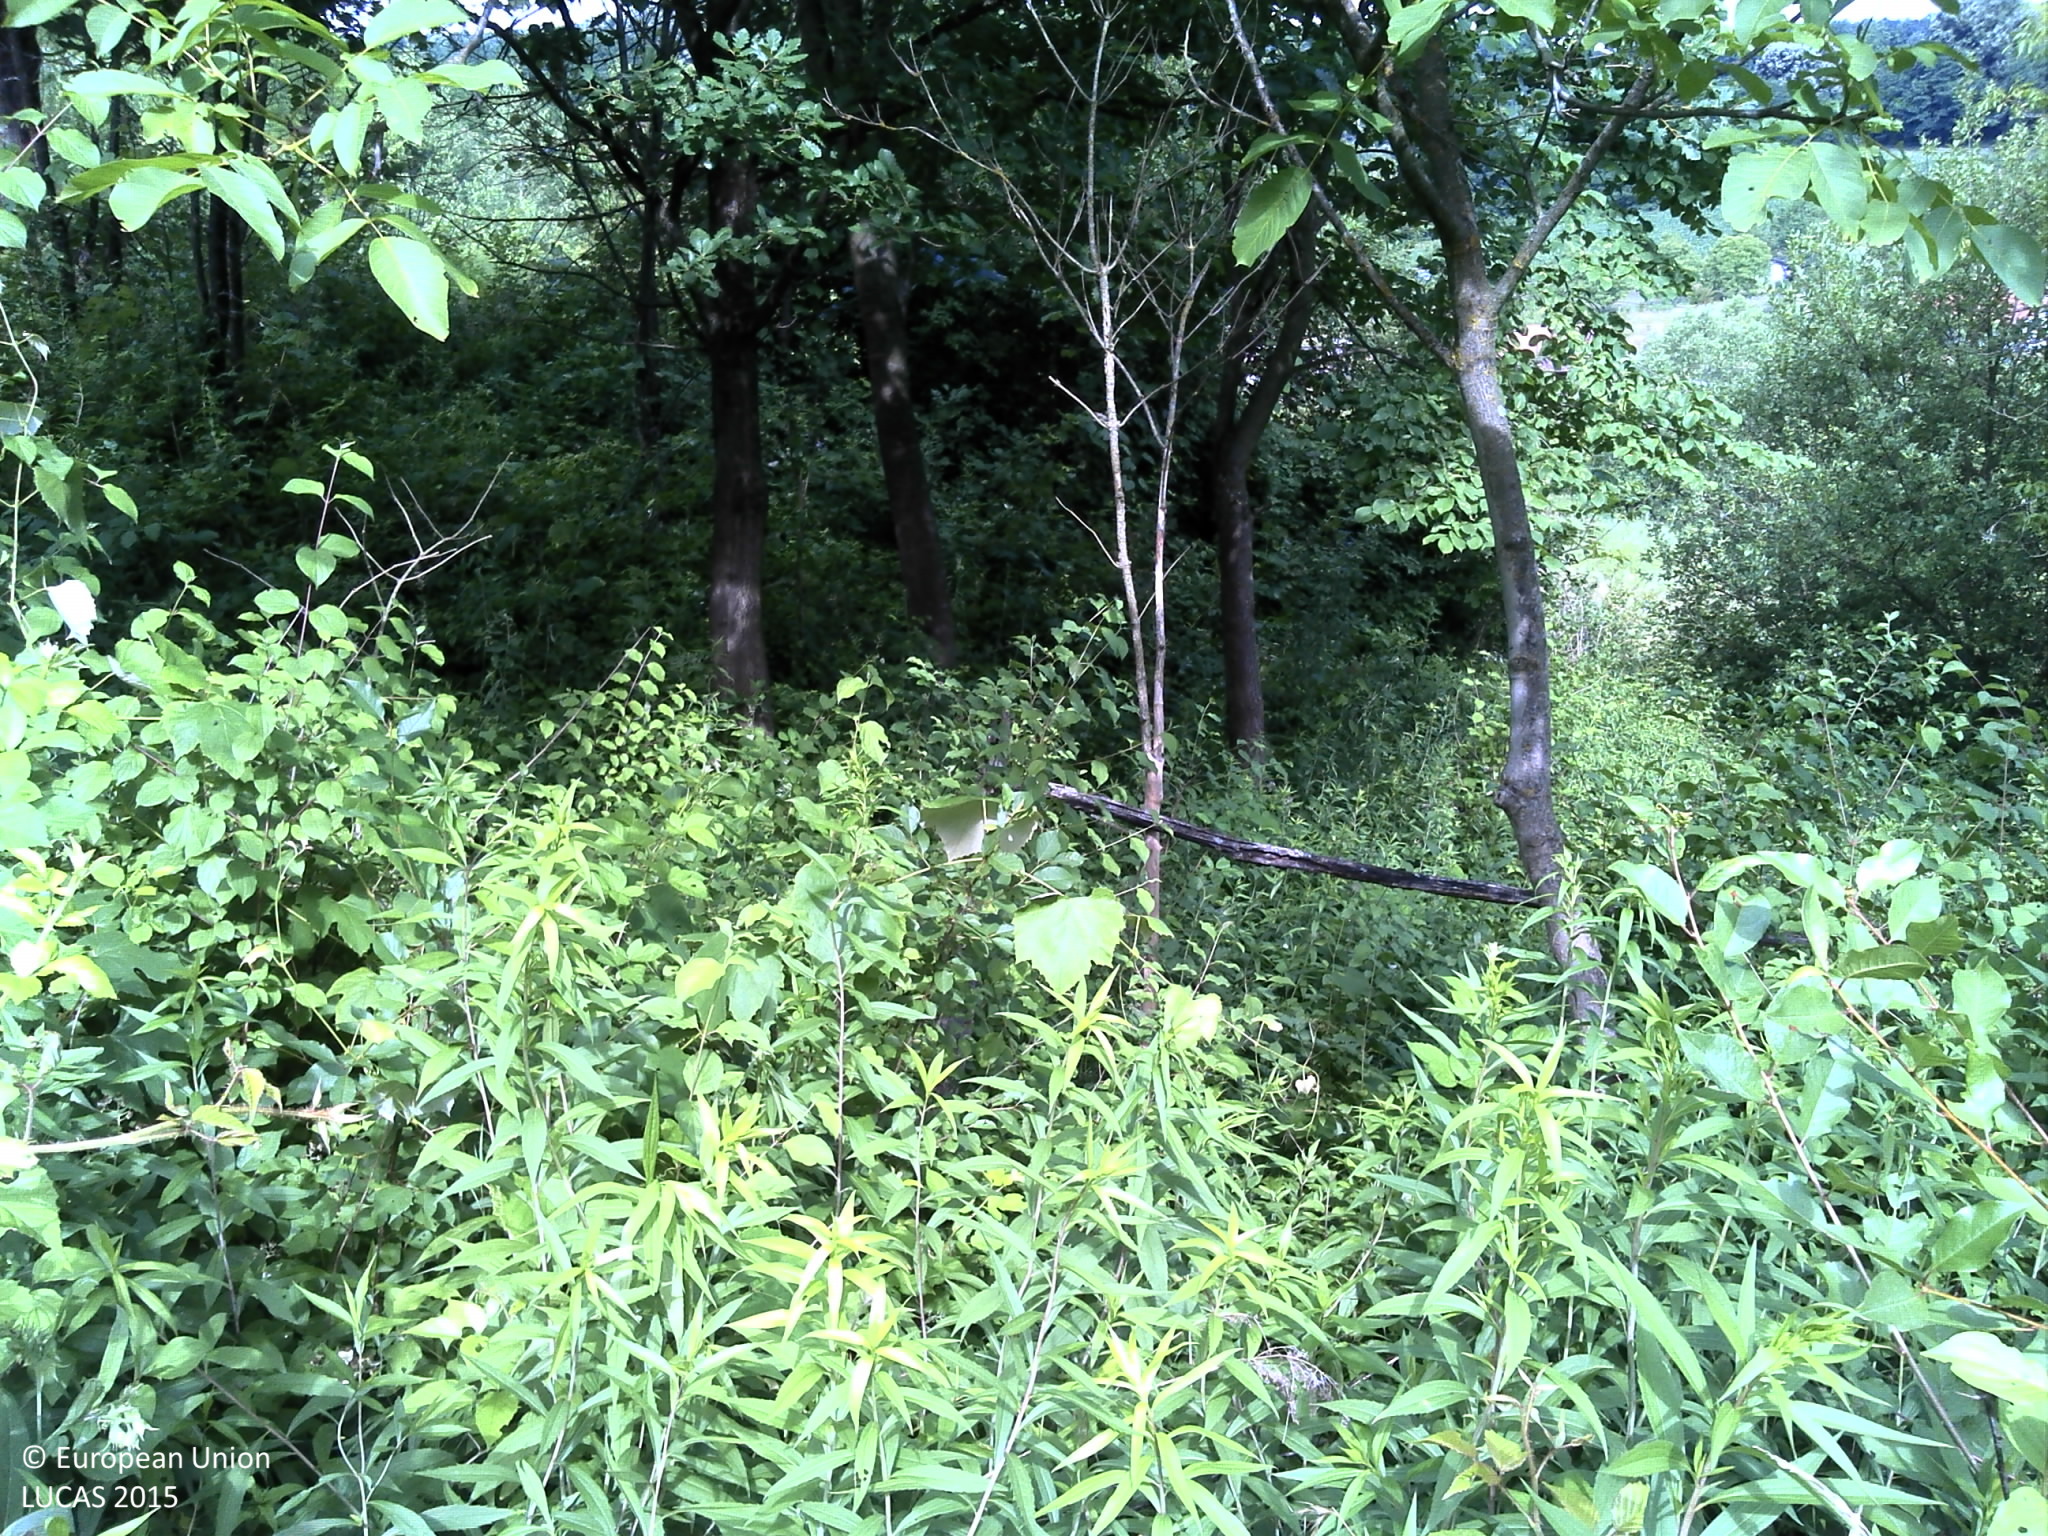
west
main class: Grassland
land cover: Spontaneously vegetated surfaces
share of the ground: > 75 %
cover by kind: herbaceous plants 100 %
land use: Fallow land
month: June
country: HR
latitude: 45.7873
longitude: 17.3985
